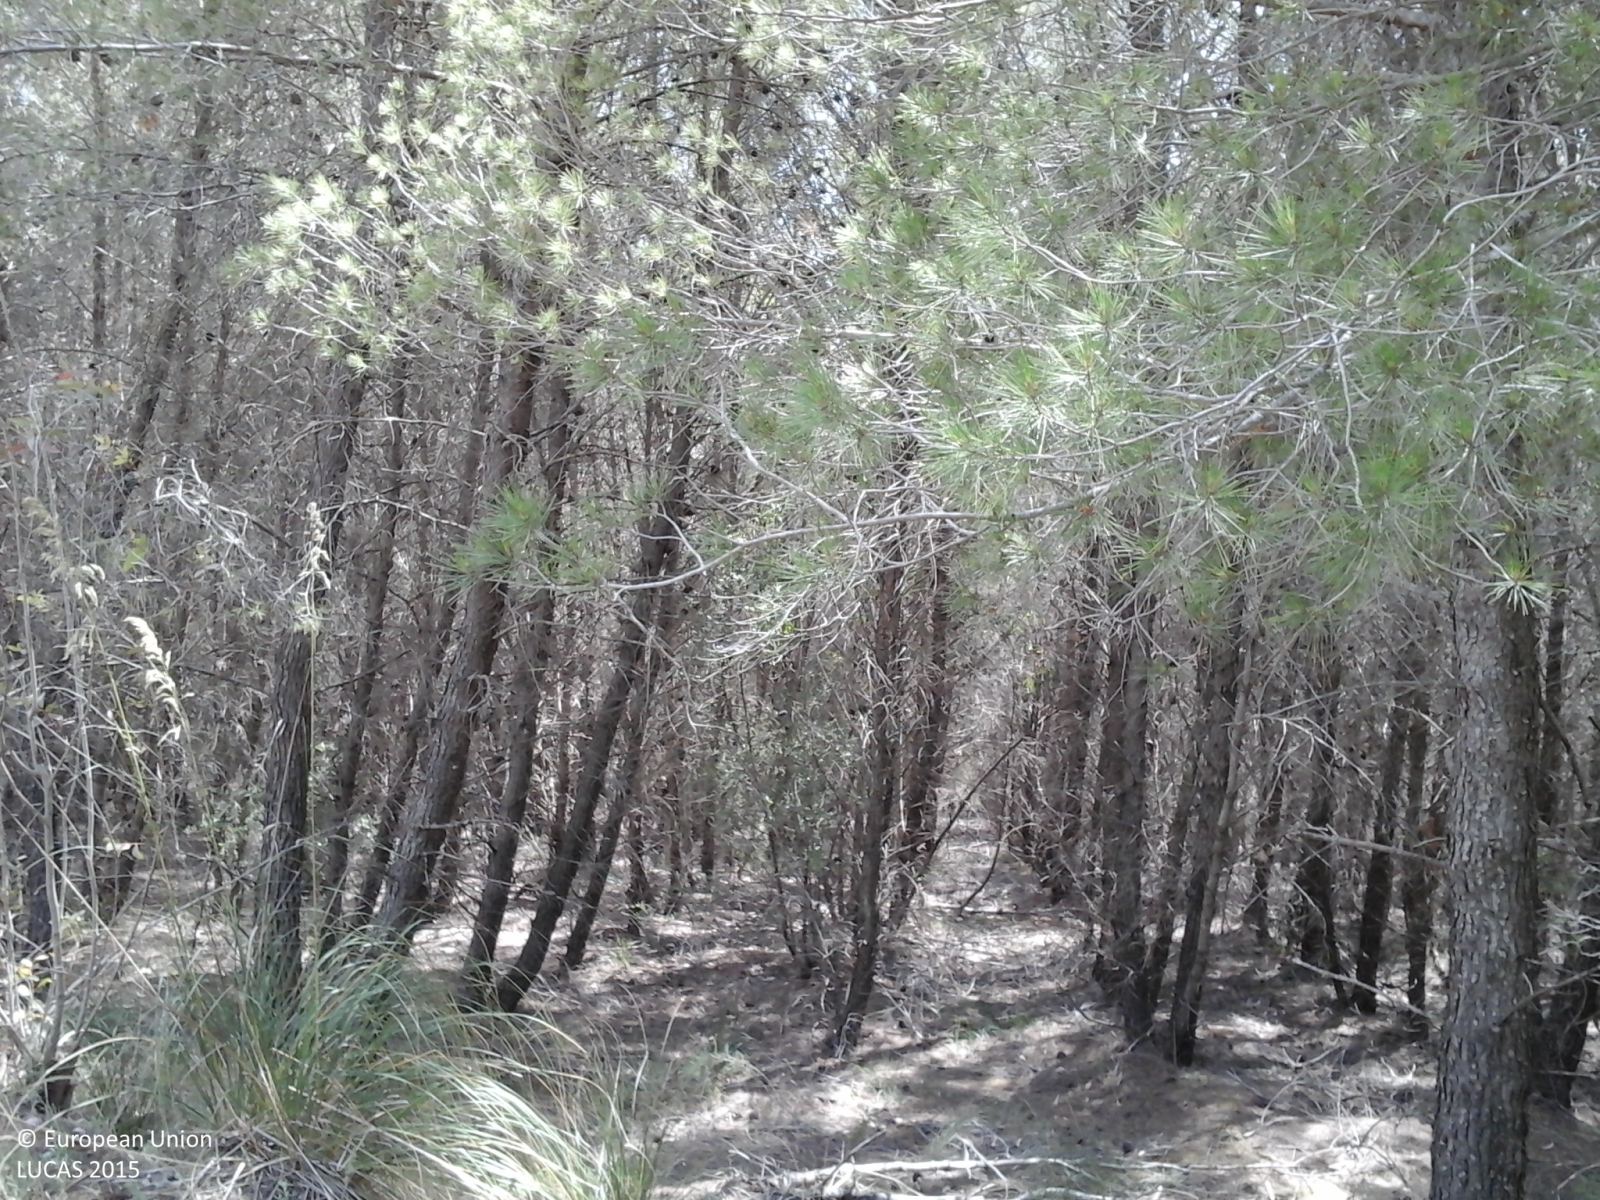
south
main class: Woodland
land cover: Broadleaved woodland
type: exotic forest
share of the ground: > 75 %
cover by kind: broadleaved forest trees 100 %
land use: Forestry
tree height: > 5 m
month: May
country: IT
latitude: 37.3194
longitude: 14.3790
